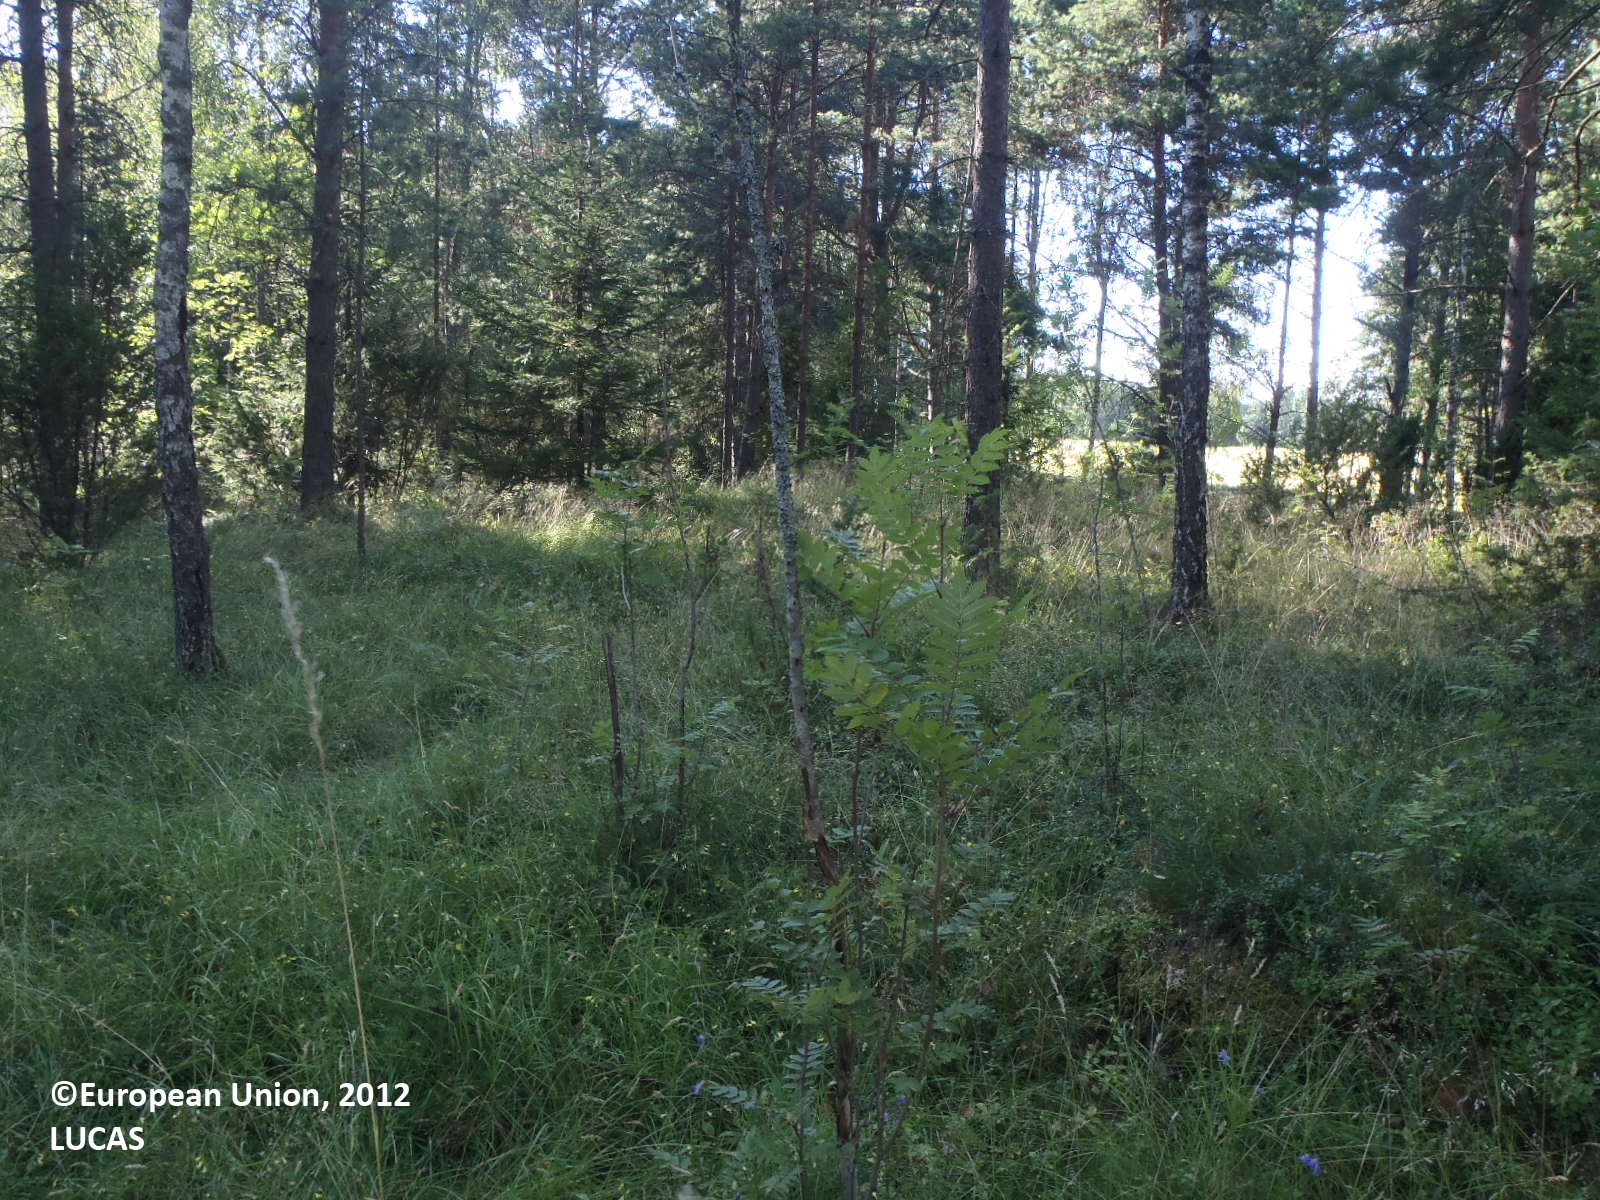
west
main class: Woodland
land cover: Pine dominated mixed woodland
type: boreal forest
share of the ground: 50 - 75 %
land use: Forestry
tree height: > 5 m
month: July
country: FI
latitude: 60.6188
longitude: 21.7350
